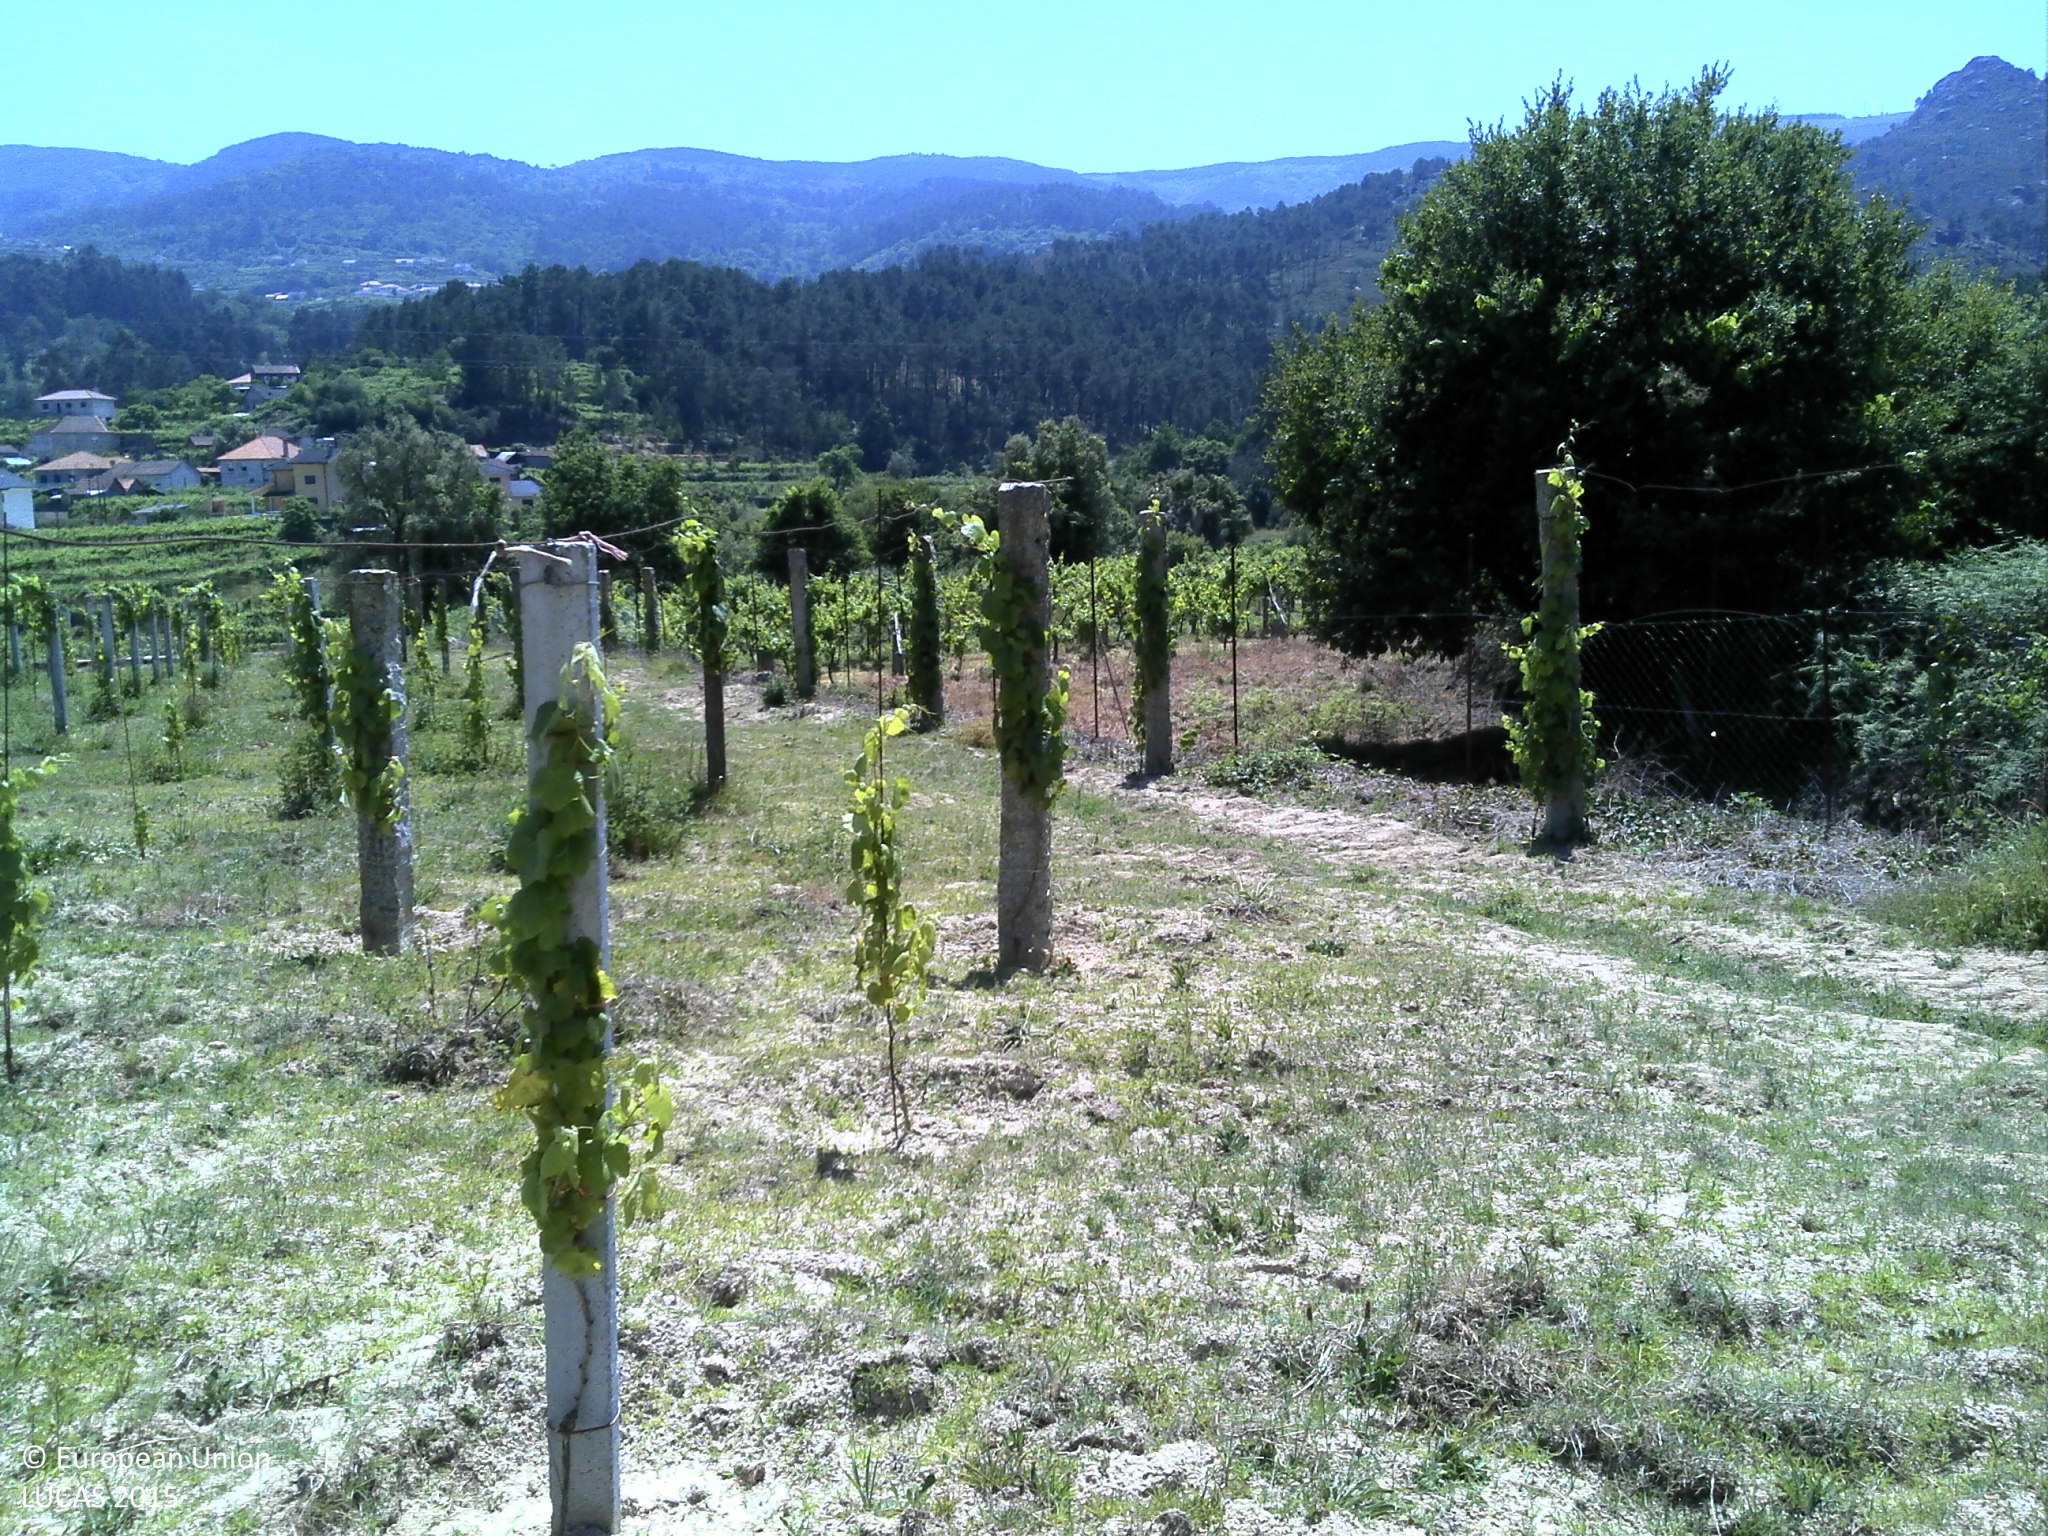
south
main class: Cropland
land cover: Vineyards
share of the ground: 10 - 25 %
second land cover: Grassland without tree/shrub cover
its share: 10 - 25 %
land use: Agriculture (excluding fallow land and kitchen gardens)
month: June
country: PT
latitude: 42.0034
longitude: -8.5031
